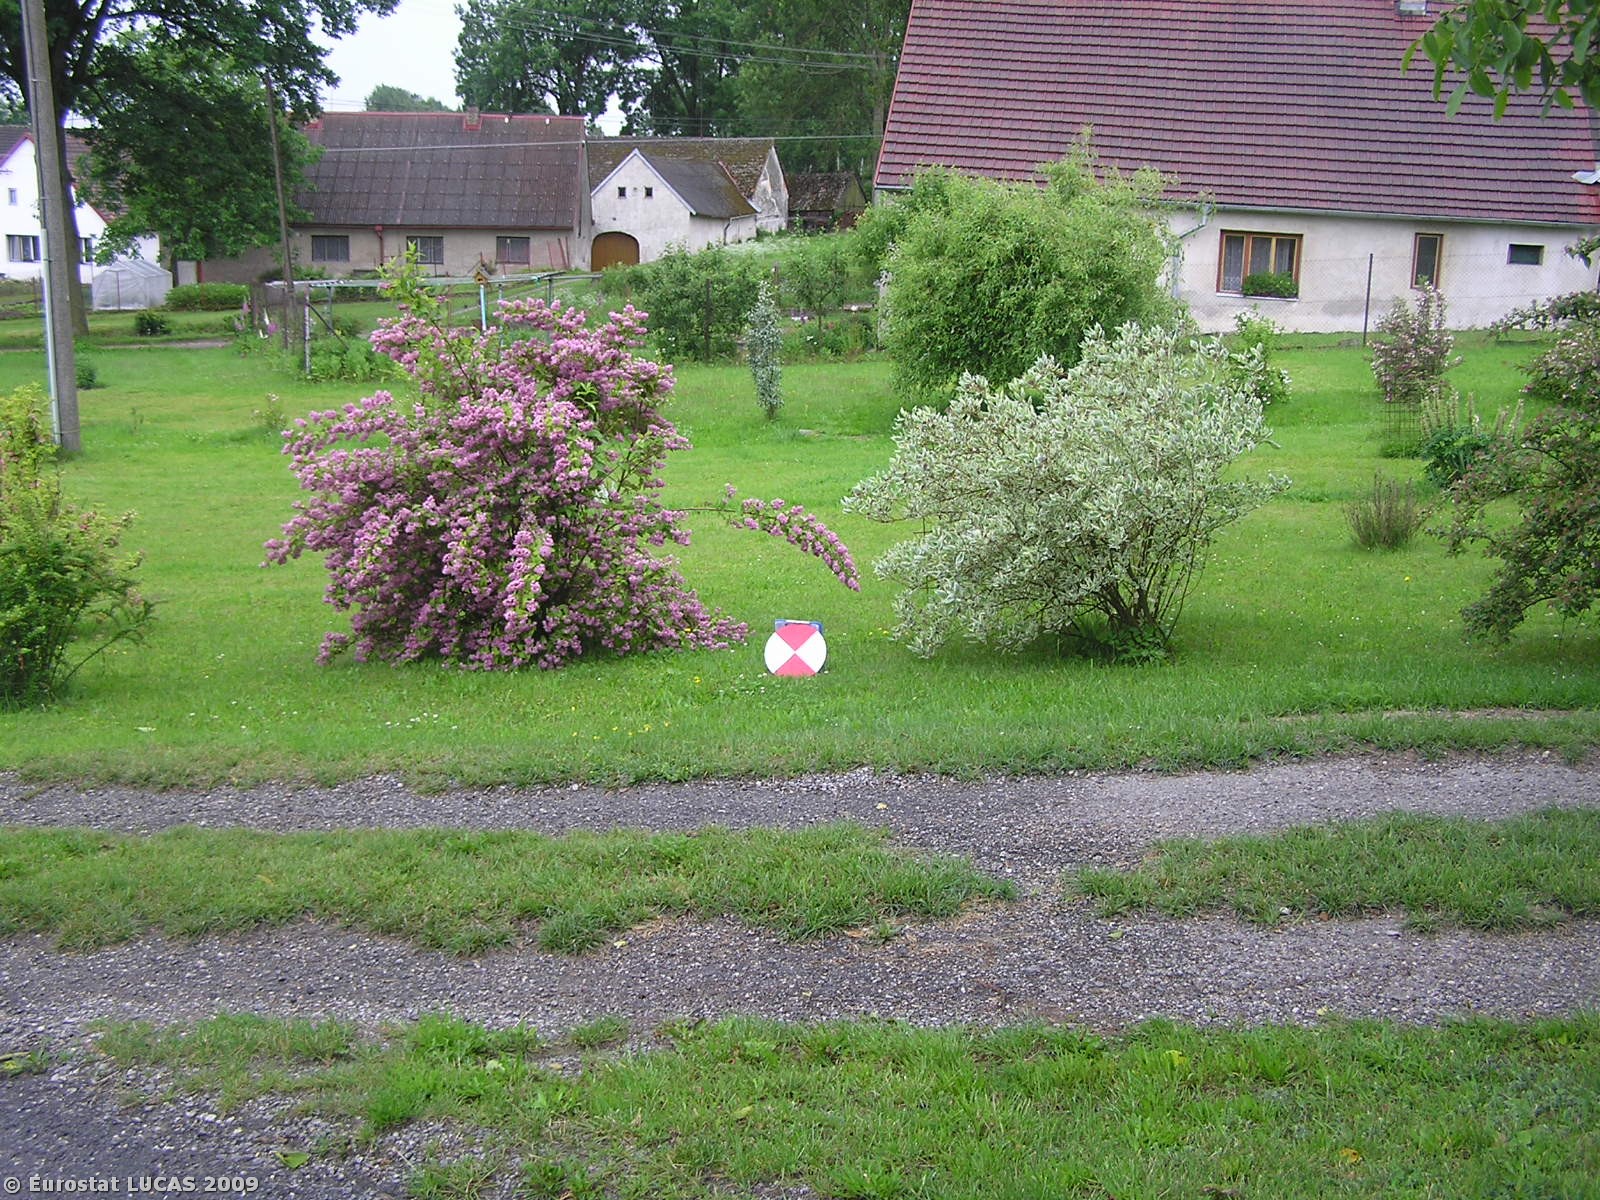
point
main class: Grassland
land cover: Grassland with sparse tree/shrub cover
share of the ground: > 75 %
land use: Residential
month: June
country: CZ
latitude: 49.1936
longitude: 14.9559
